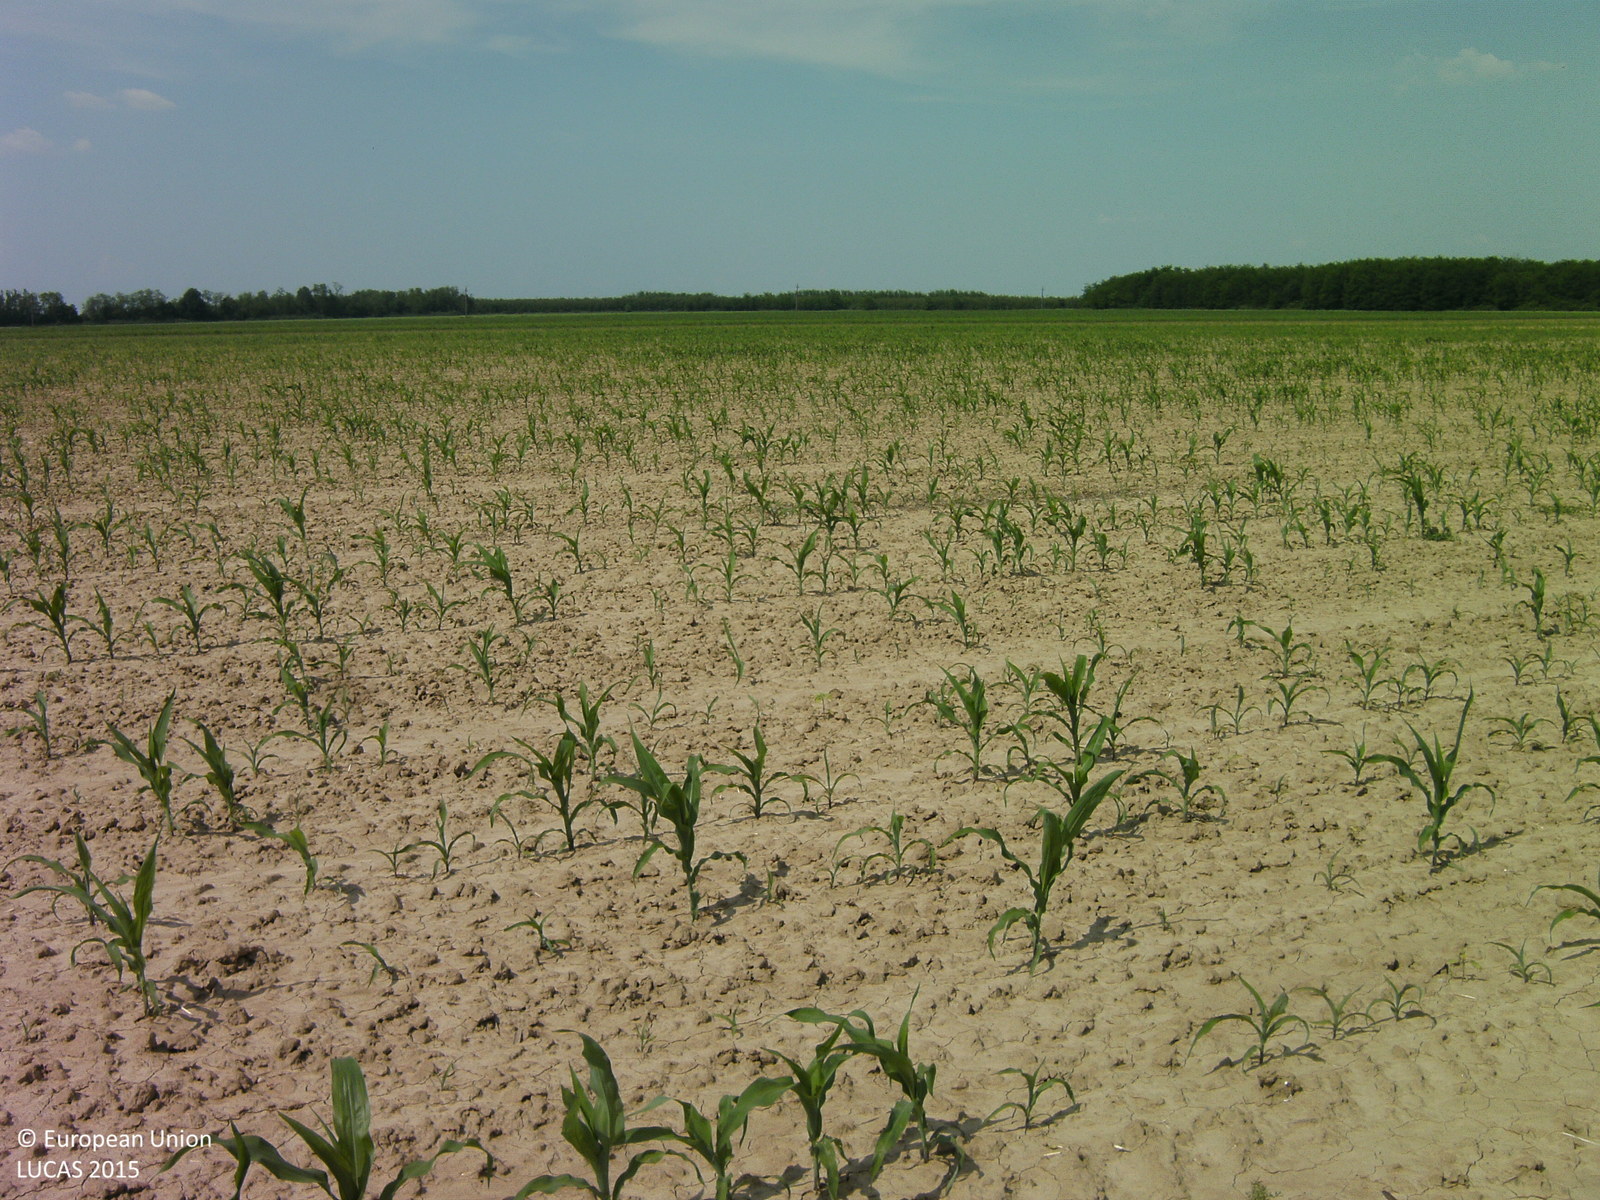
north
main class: Cropland
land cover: Maize
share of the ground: 10 - 25 %
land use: Agriculture (excluding fallow land and kitchen gardens)
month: June
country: HU
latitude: 46.4316
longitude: 17.7492
